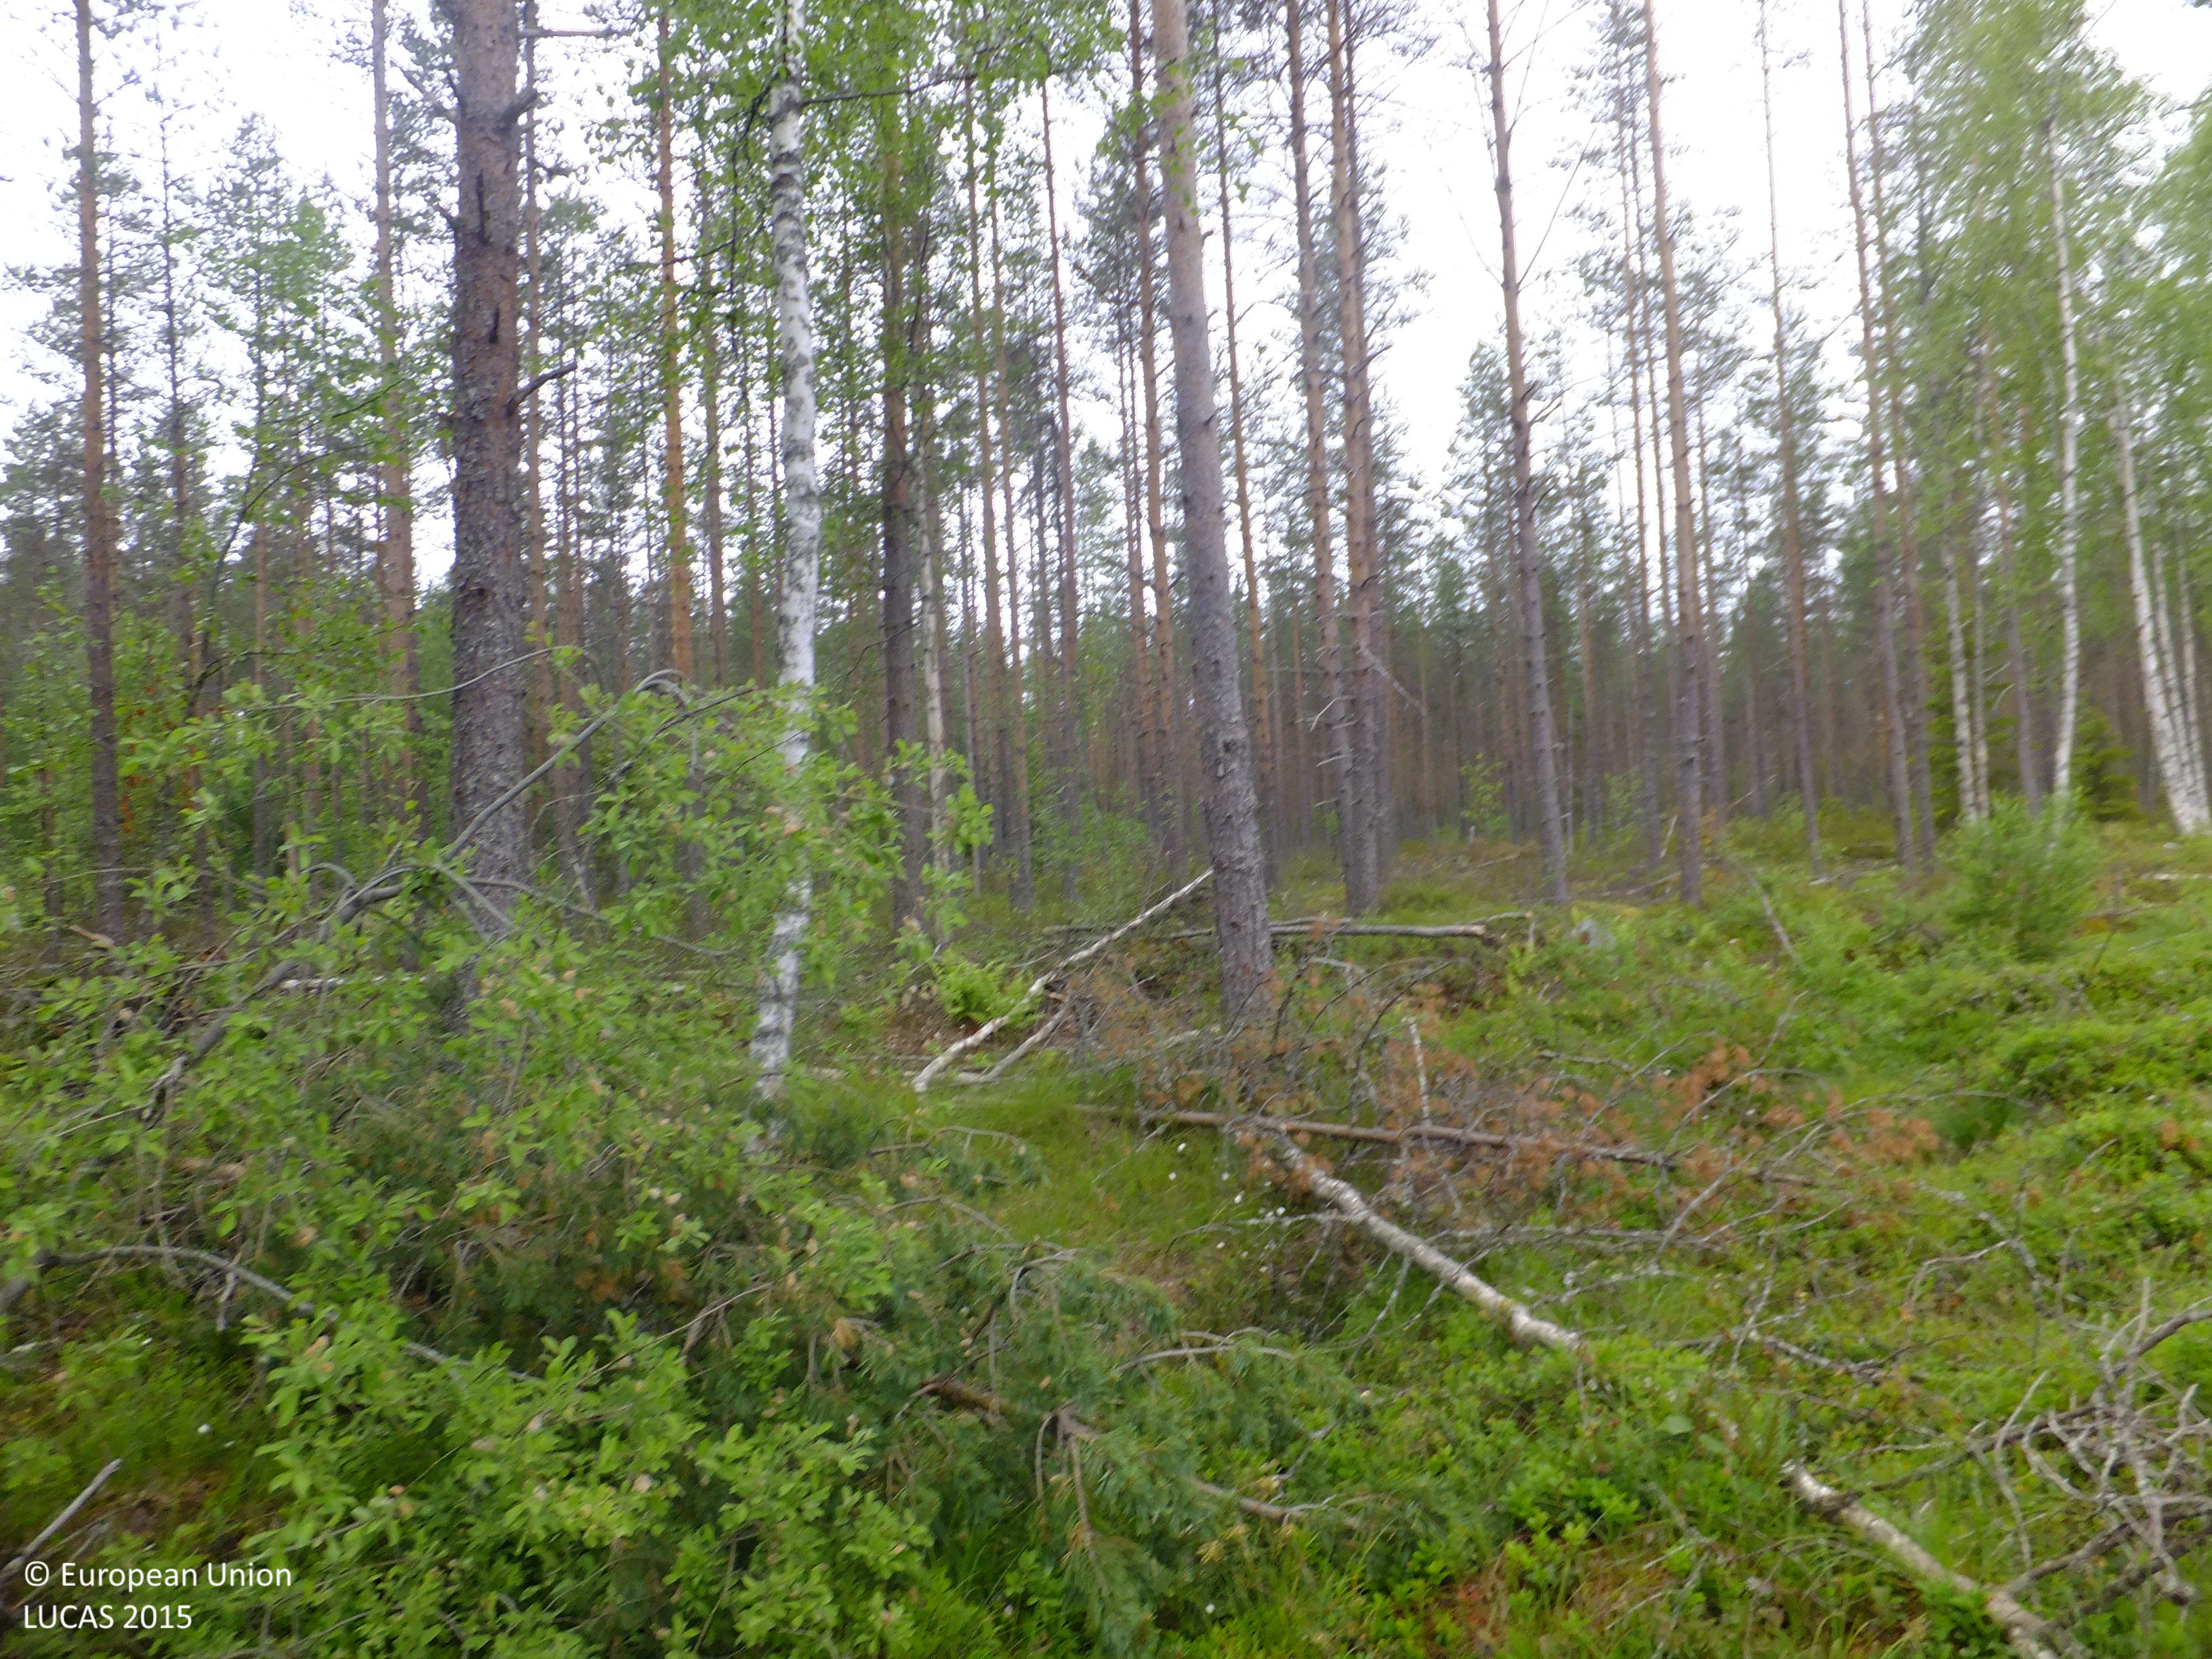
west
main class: Shrubland
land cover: Shrubland with sparse tree cover
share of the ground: 50 - 75 %
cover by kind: shrubs 50 %, herbaceous plants 20 %, lichens and mosses 10 %, unconsolidated bare surface 10 %, broadleaved forest trees 5 %, consolidated bare surface 5 %
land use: Forestry
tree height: > 5 m
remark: Clear cut
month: July
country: FI
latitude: 63.1640
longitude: 24.8021
